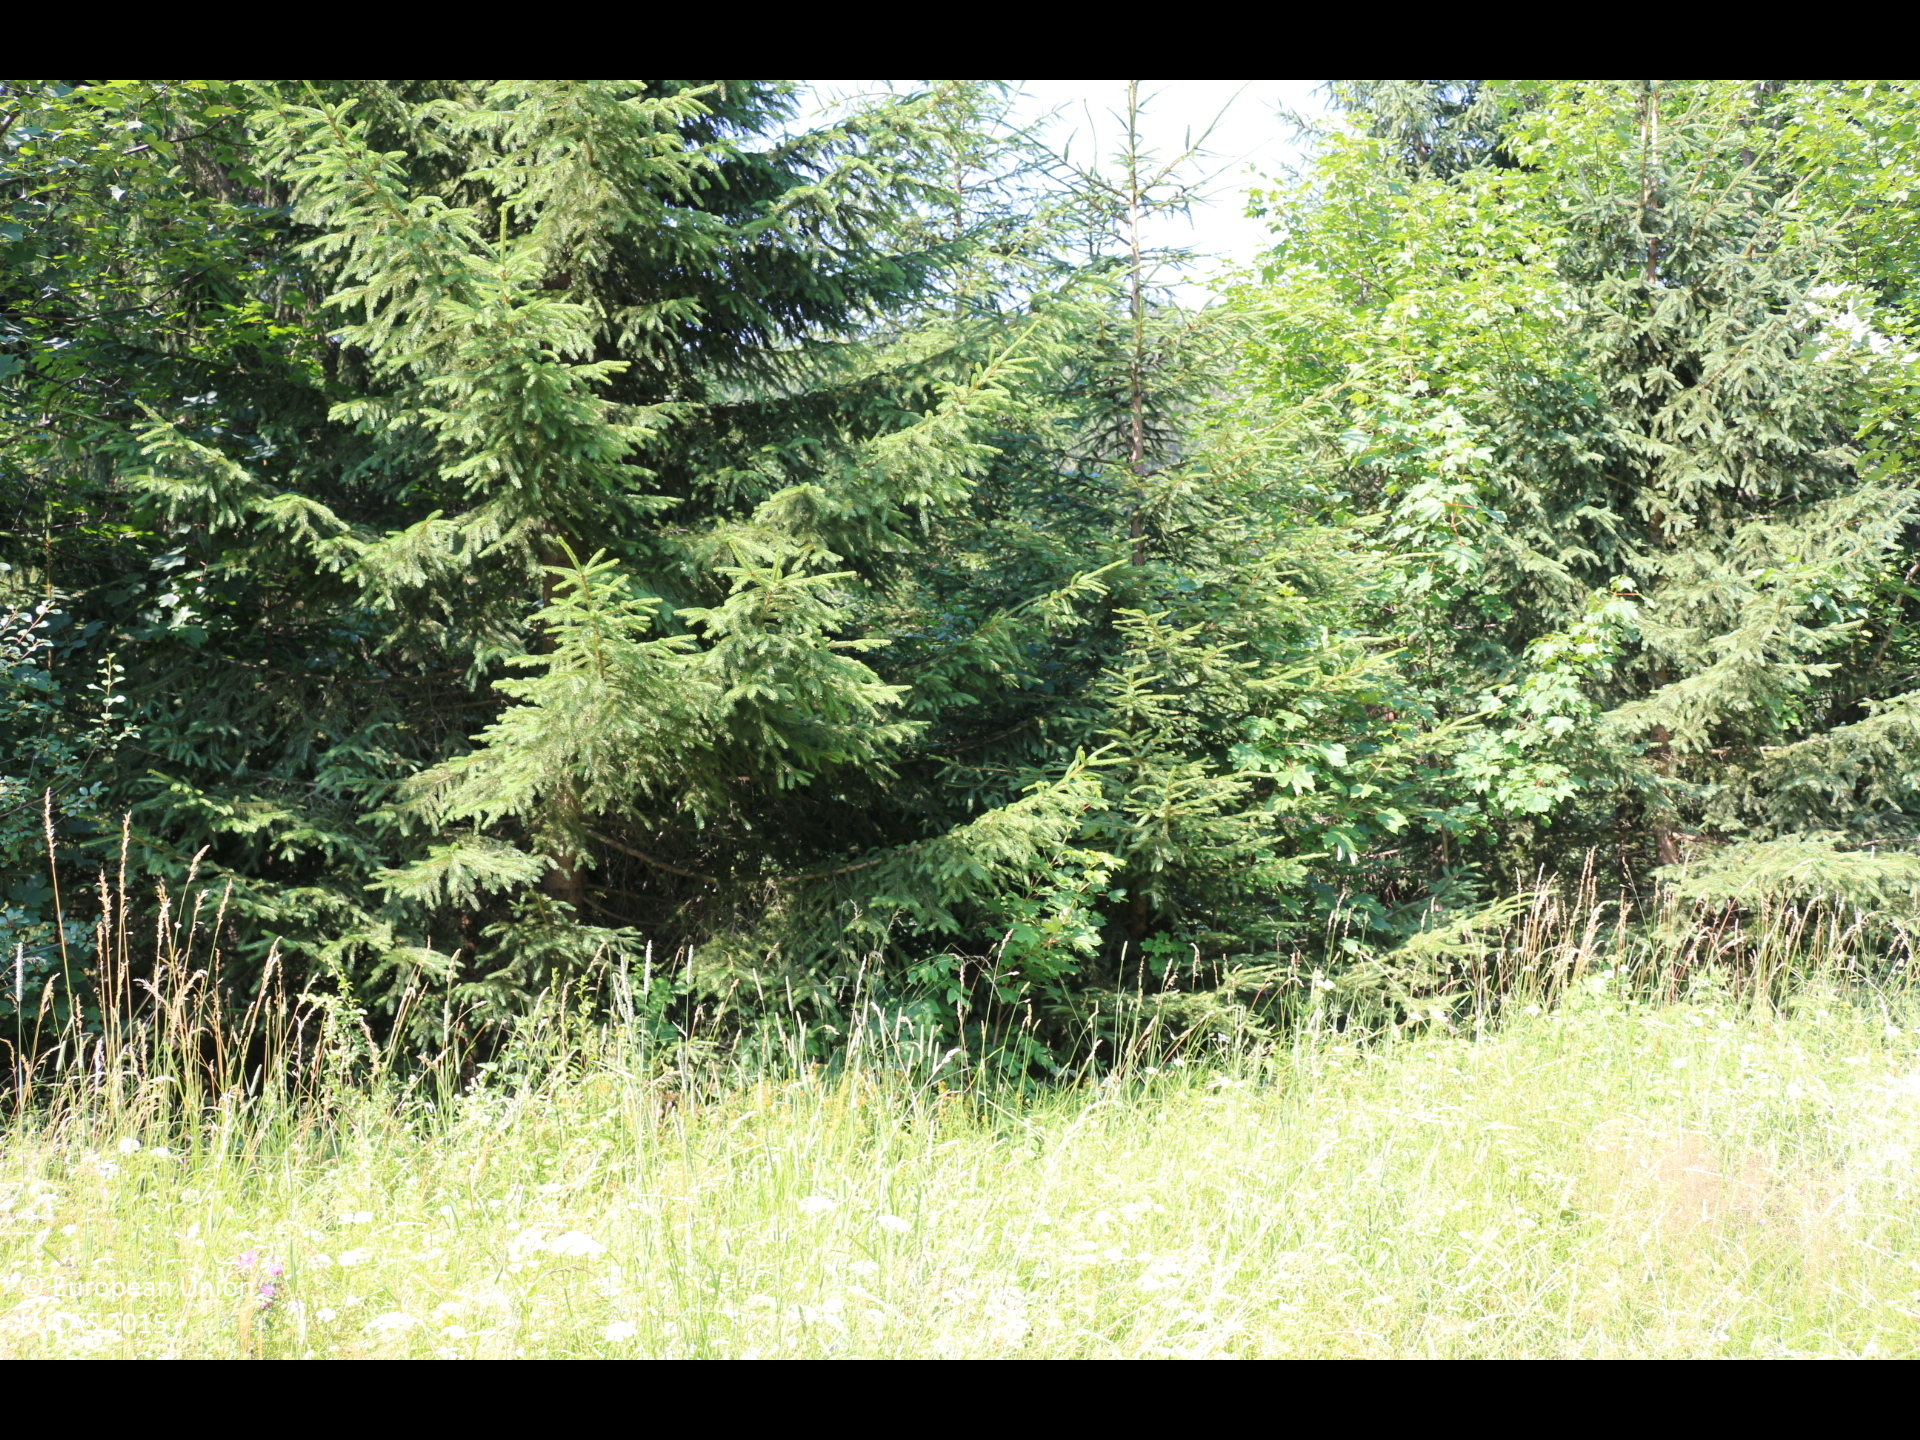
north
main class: Grassland
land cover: Grassland without tree/shrub cover
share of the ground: > 75 %
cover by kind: herbaceous plants 100 %
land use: Agriculture (excluding fallow land and kitchen gardens)
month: July
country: AT
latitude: 46.7777
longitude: 14.0969
